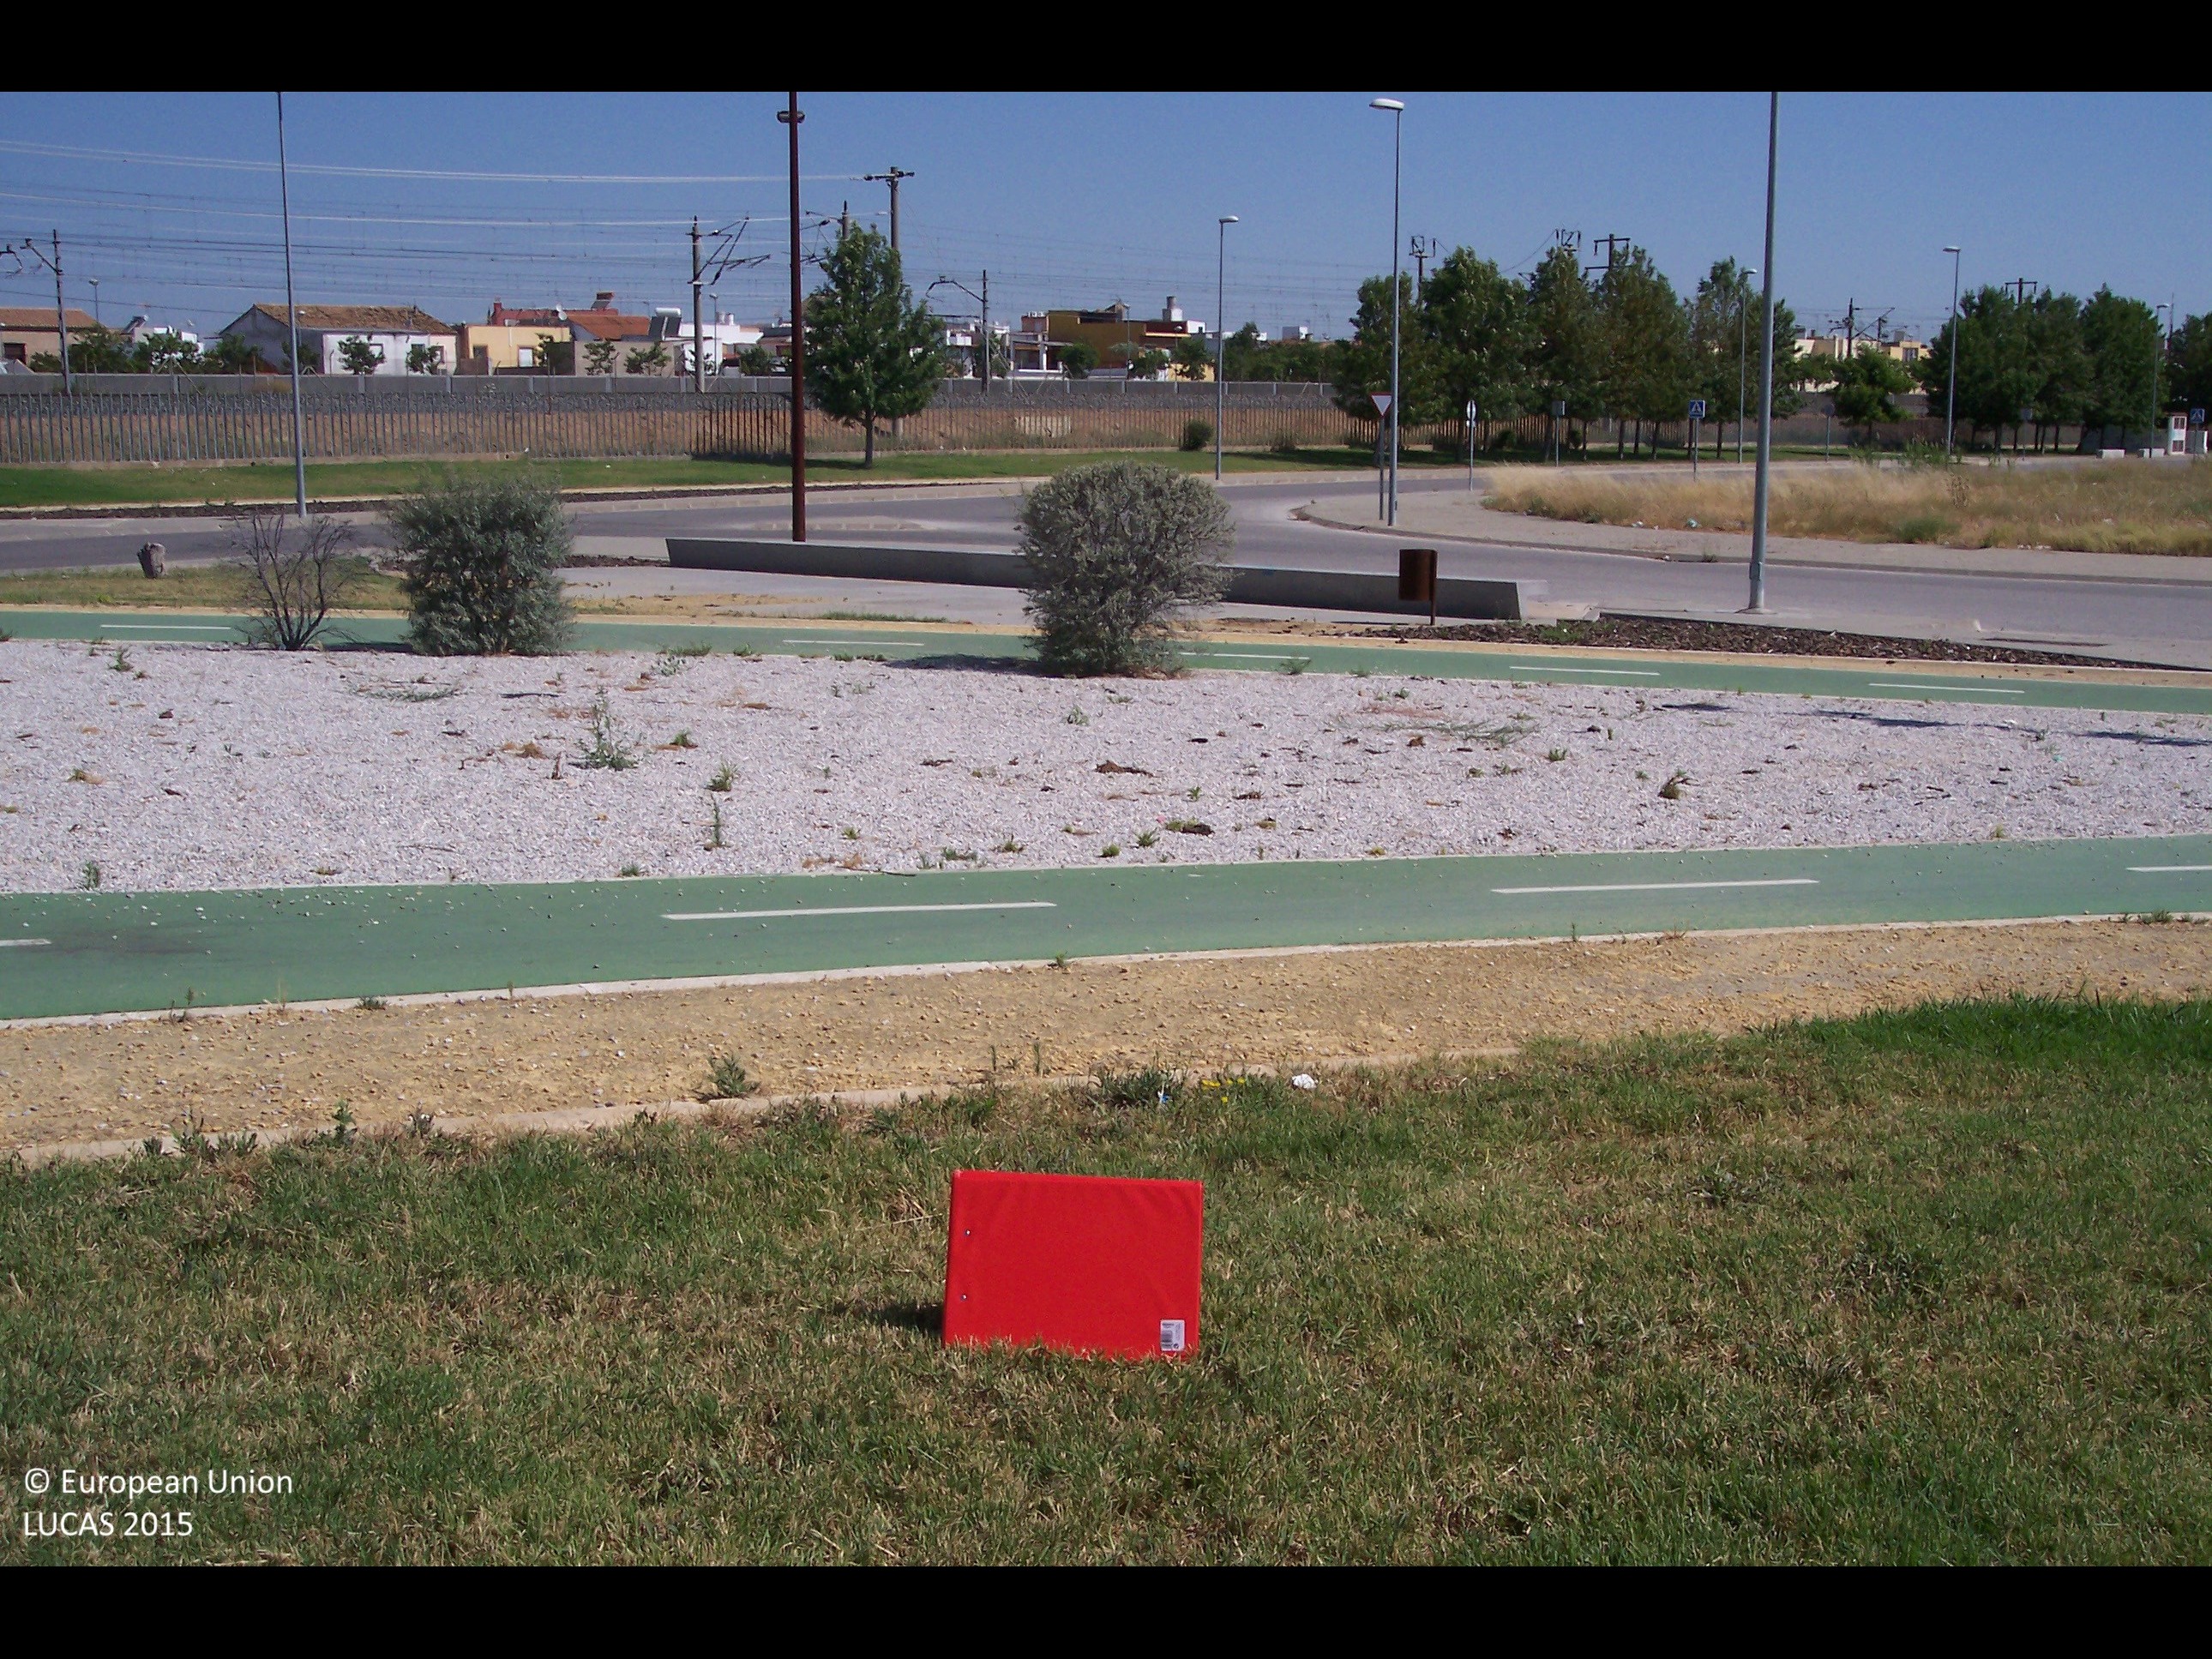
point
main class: Grassland
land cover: Grassland without tree/shrub cover
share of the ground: > 75 %
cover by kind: herbaceous plants 100 %
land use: Amenities, museums, leisure
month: May
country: ES
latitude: 37.4820
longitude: -5.9360
